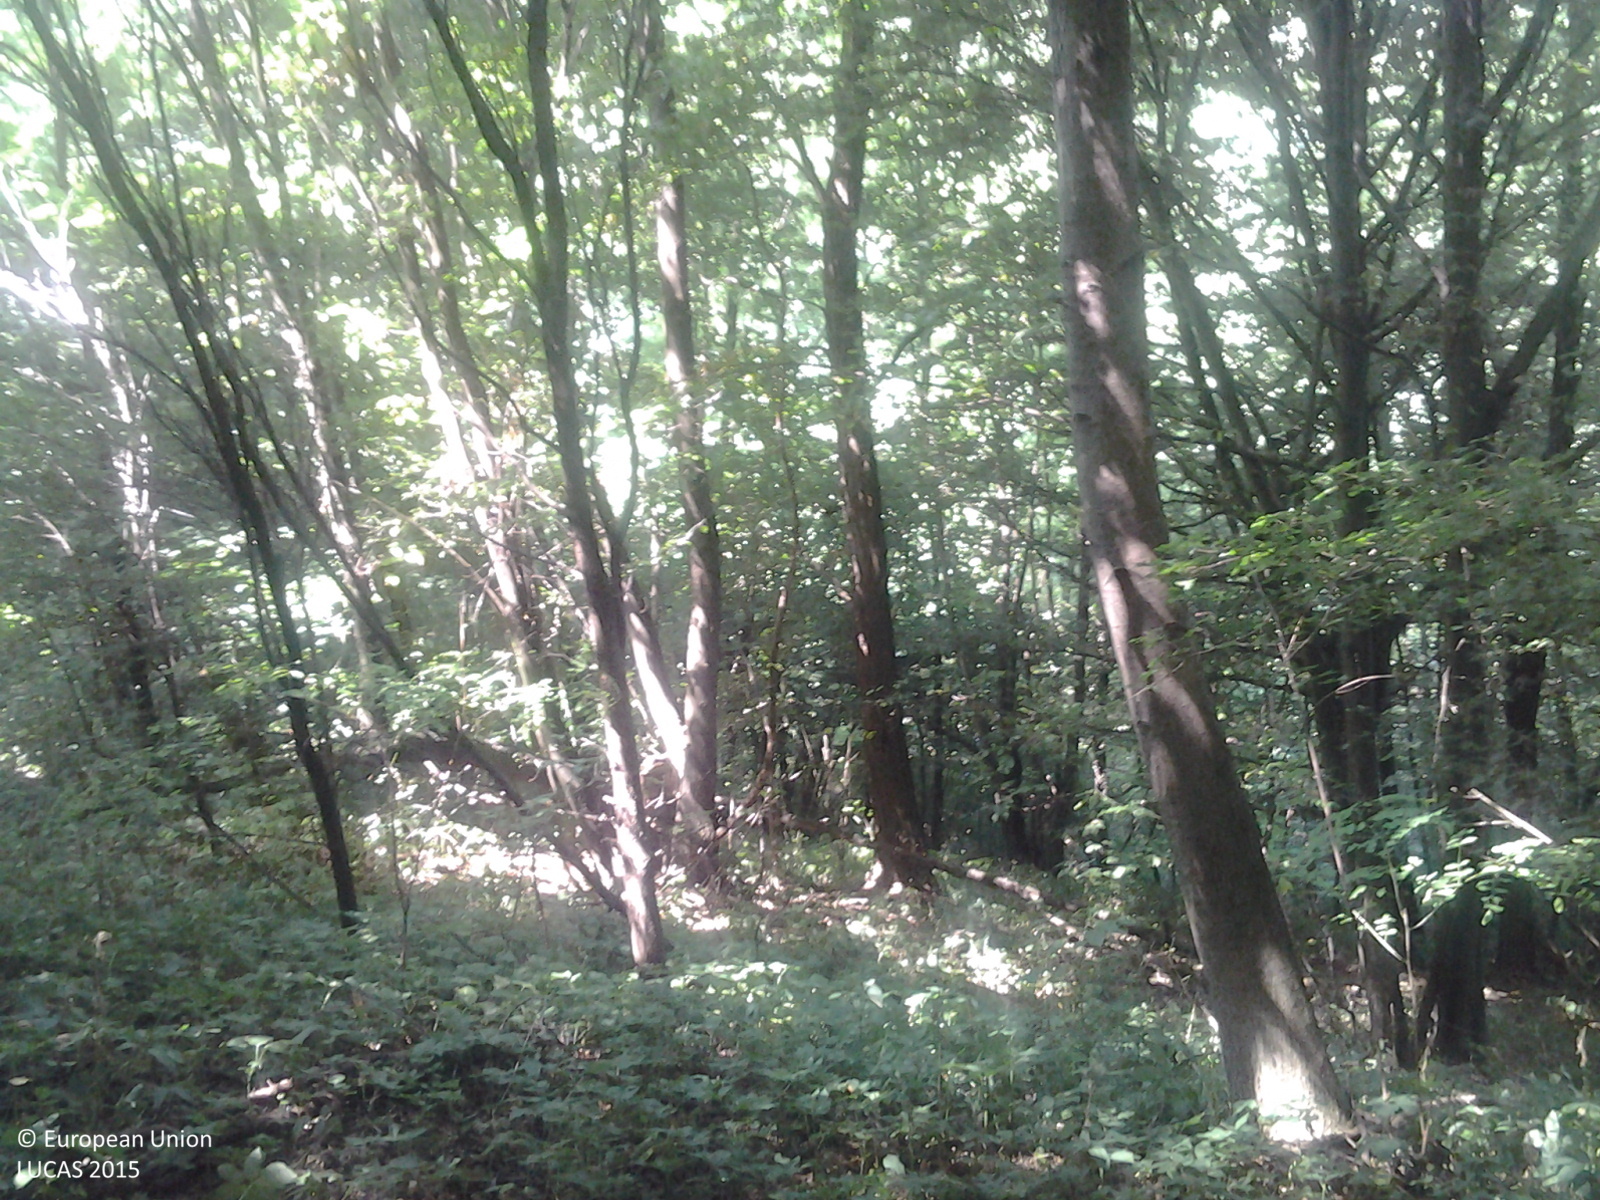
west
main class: Woodland
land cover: Broadleaved woodland
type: beech forest
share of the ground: > 75 %
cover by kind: broadleaved forest trees 100 %
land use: Forestry
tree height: > 5 m
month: August
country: HU
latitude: 46.5679
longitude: 17.0877
